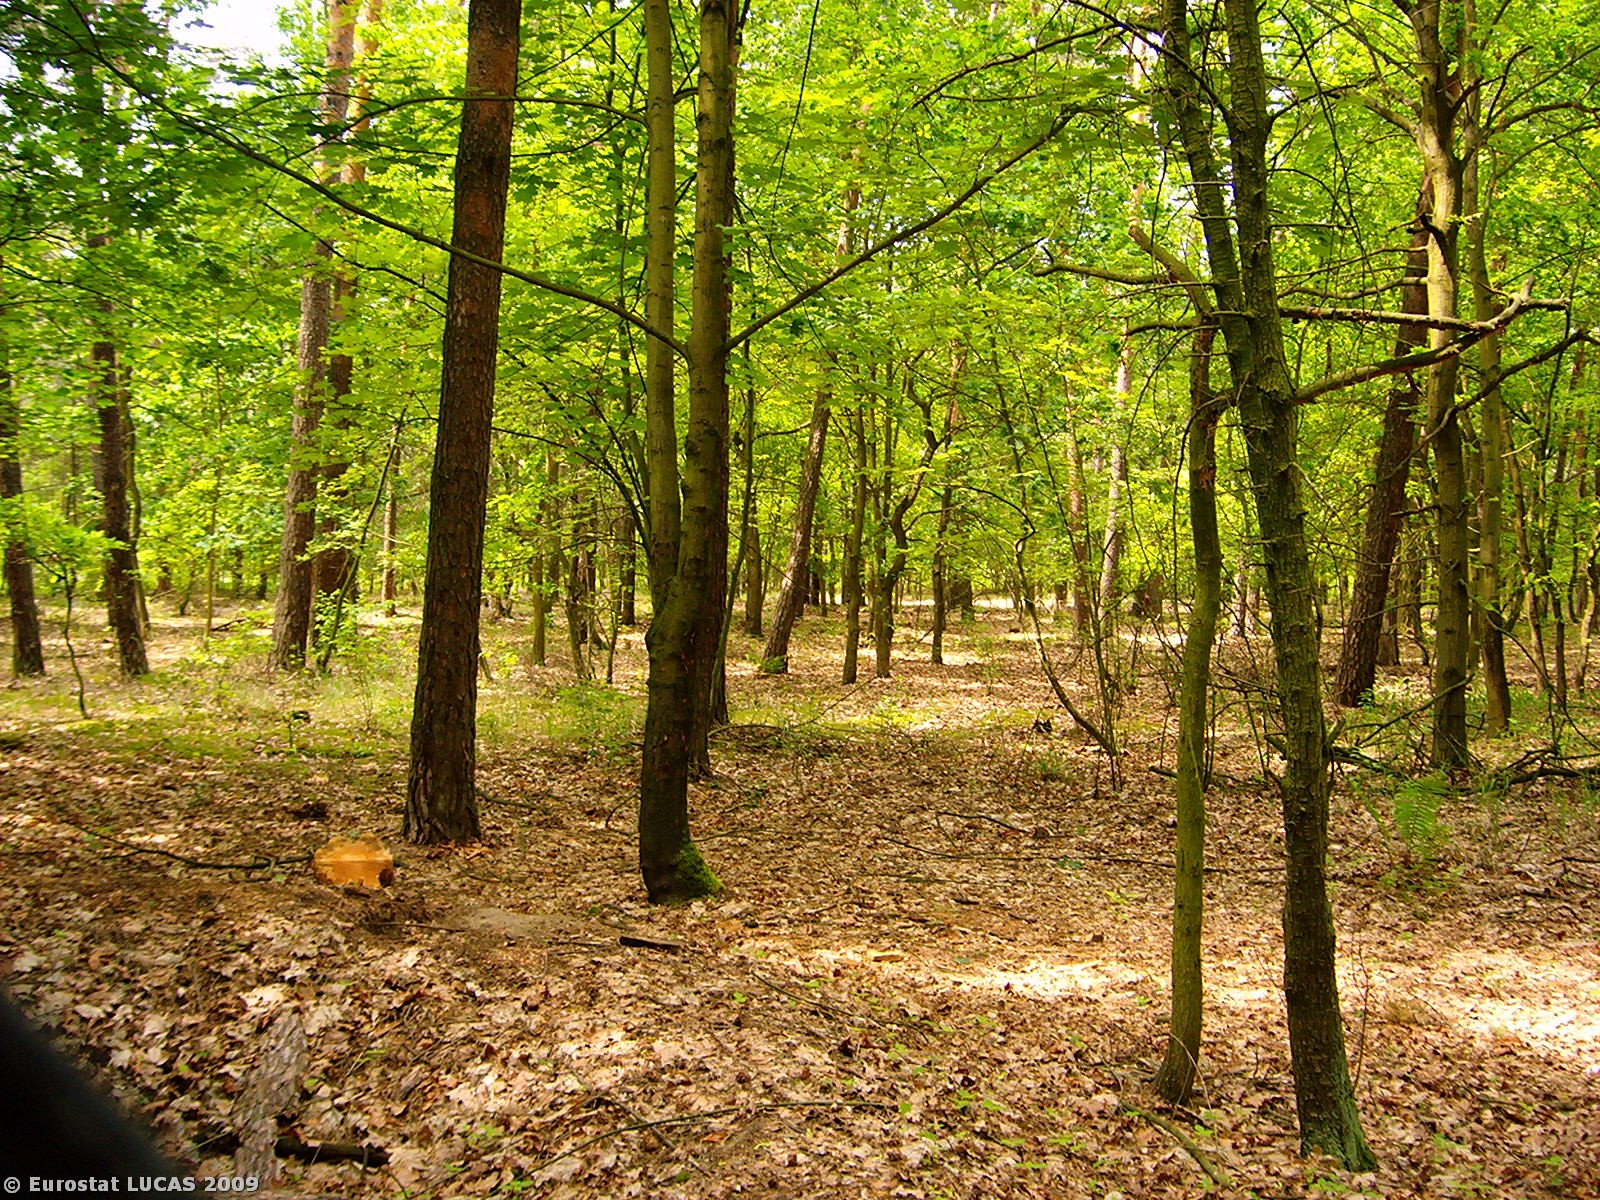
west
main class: Woodland
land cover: Mixed woodland
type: hemiboreal forest and nemoral coniferous forest and mixed broadleaved-coniferous forest
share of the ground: > 75 %
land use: Forestry
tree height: > 5 m
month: May
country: PL
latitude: 52.5327
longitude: 16.9825
